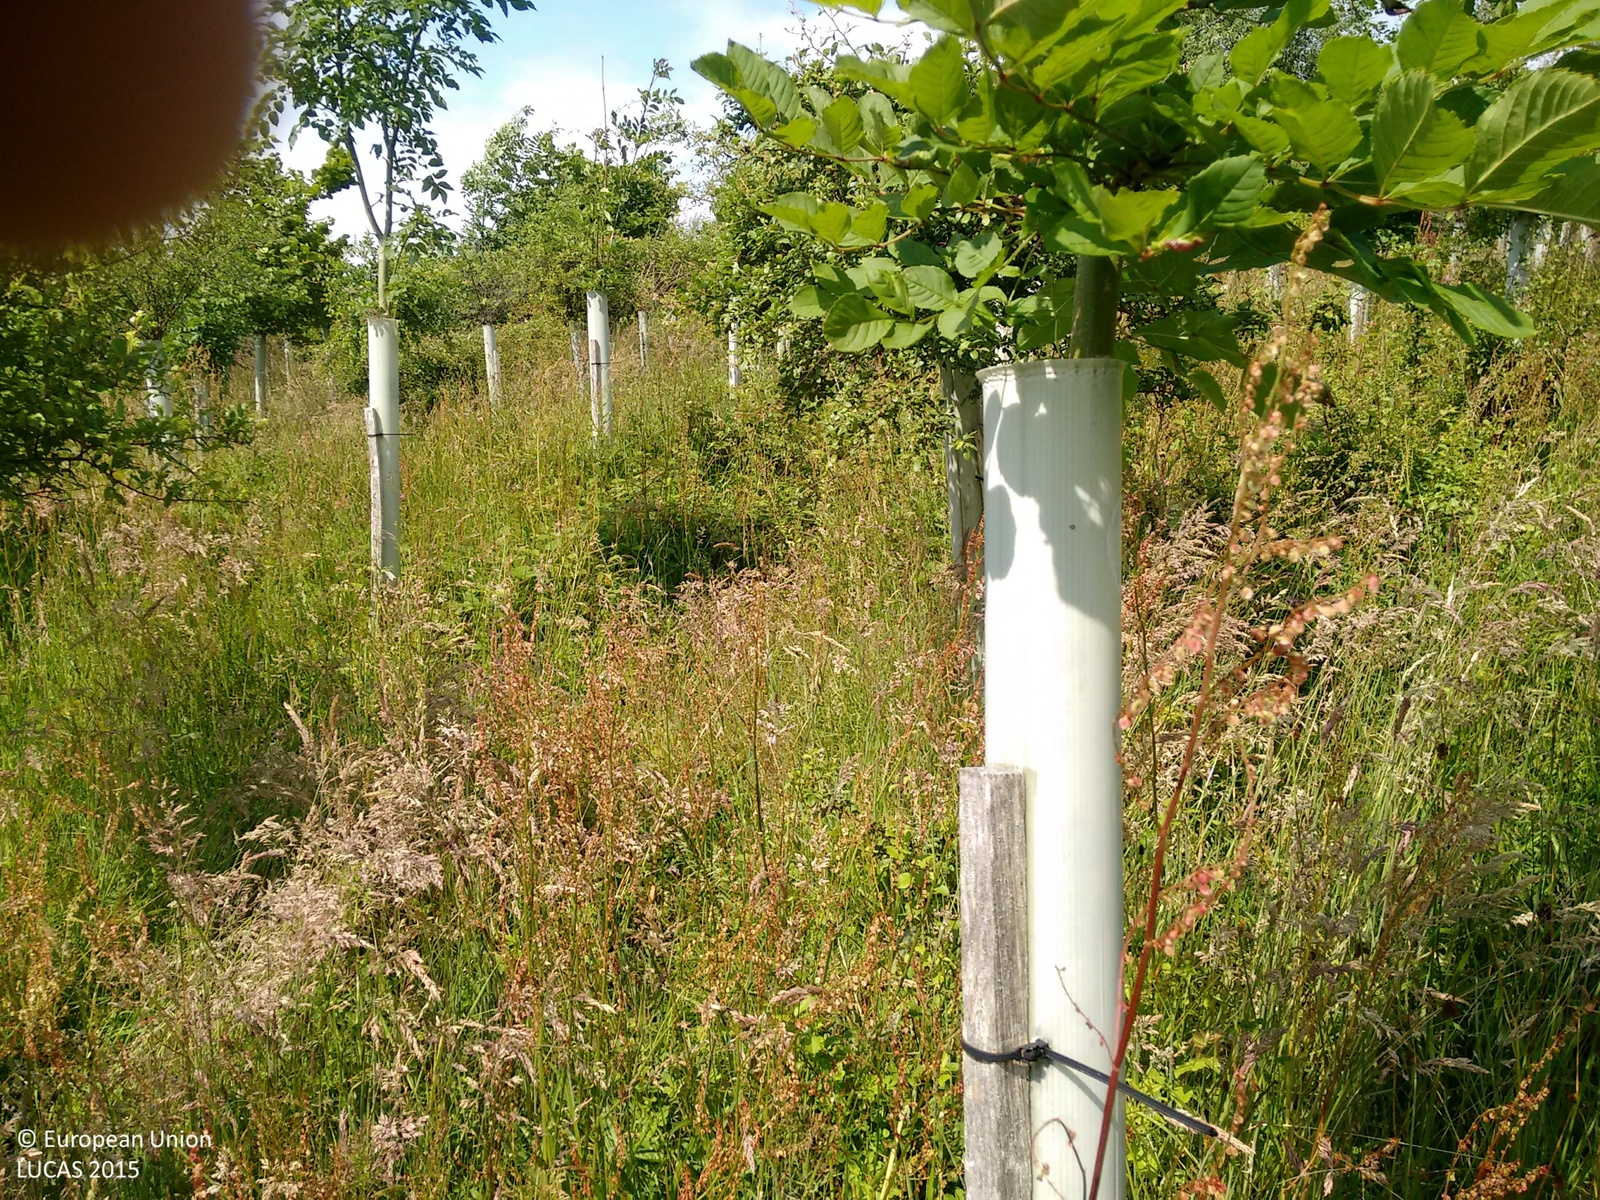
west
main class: Woodland
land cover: Broadleaved woodland
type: mesophytic deciduous forest
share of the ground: 50 - 75 %
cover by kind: broadleaved forest trees 70 %, herbaceous plants 20 %, lichens and mosses 10 %
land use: Forestry
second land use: Amenities, museums, leisure
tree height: < 5 m
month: July
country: GB
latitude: 55.7152
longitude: -4.7330
